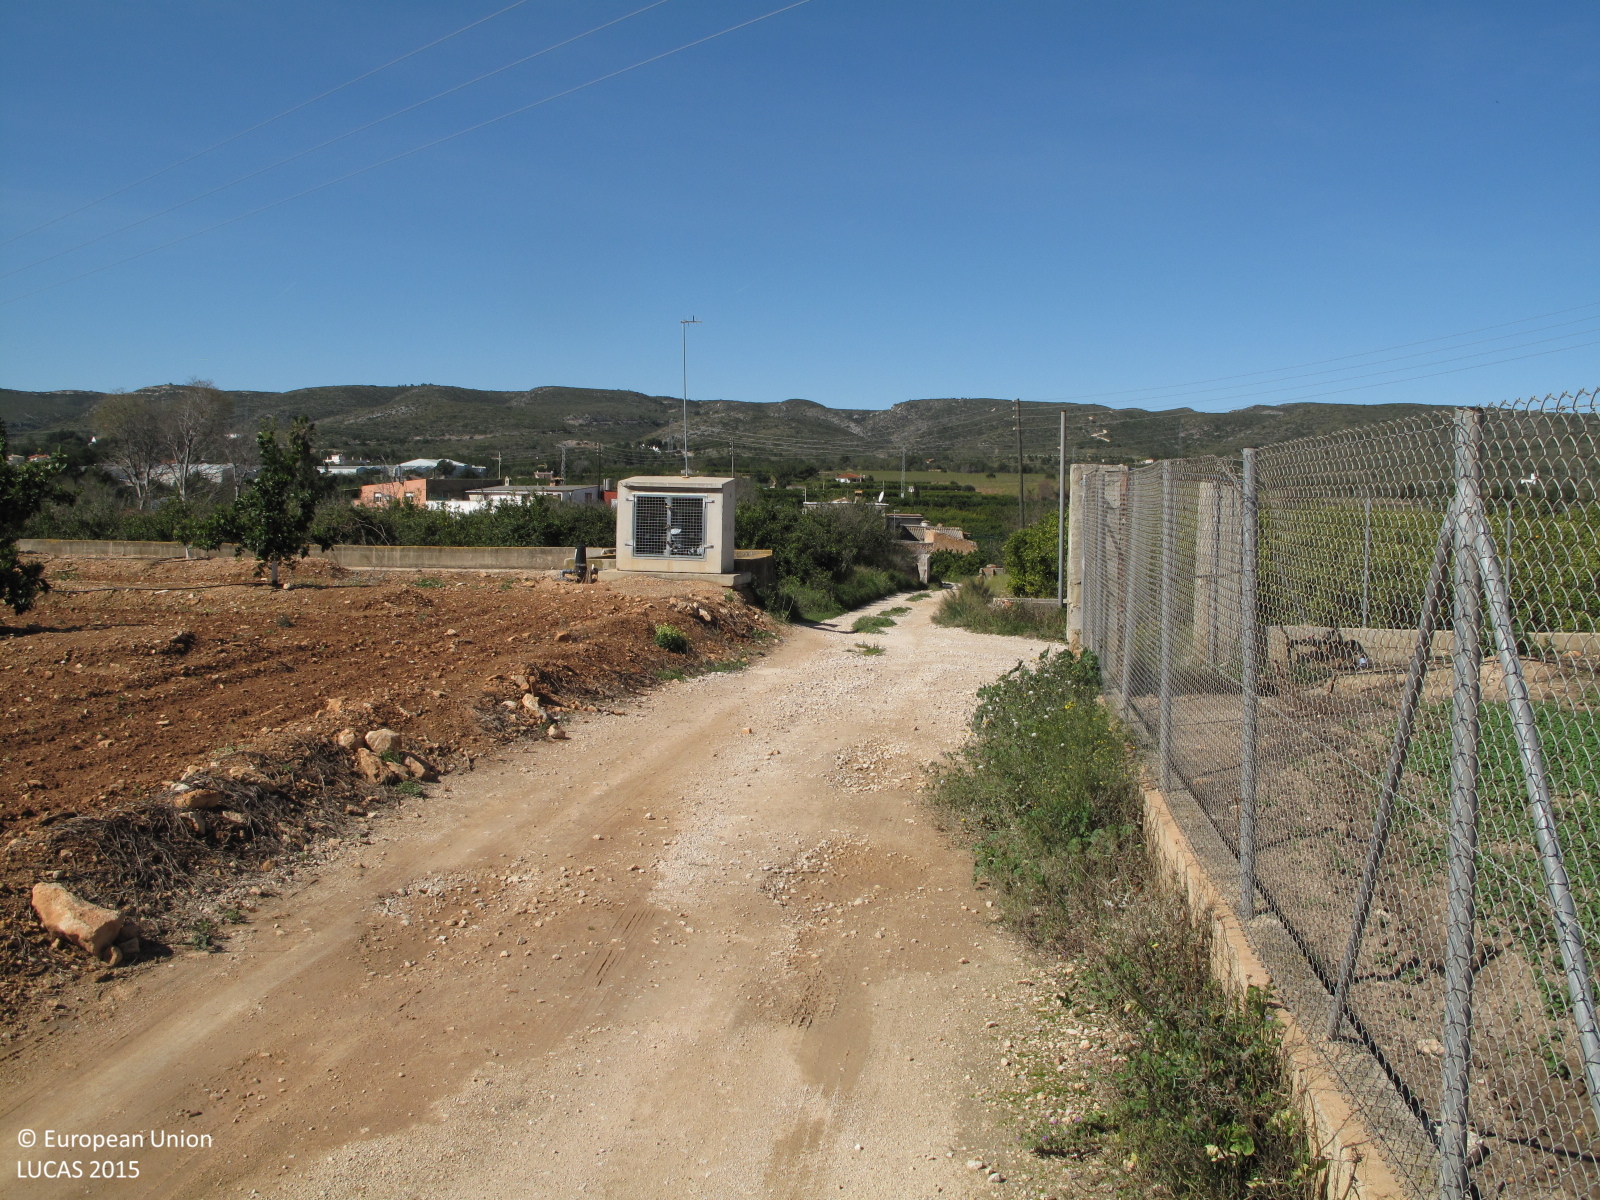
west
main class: Cropland
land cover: Oranges
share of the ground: 10 - 25 %
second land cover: Spontaneously vegetated surfaces
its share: 10 - 25 %
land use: Agriculture (excluding fallow land and kitchen gardens)
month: March
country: ES
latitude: 39.1462
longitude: -0.5818
